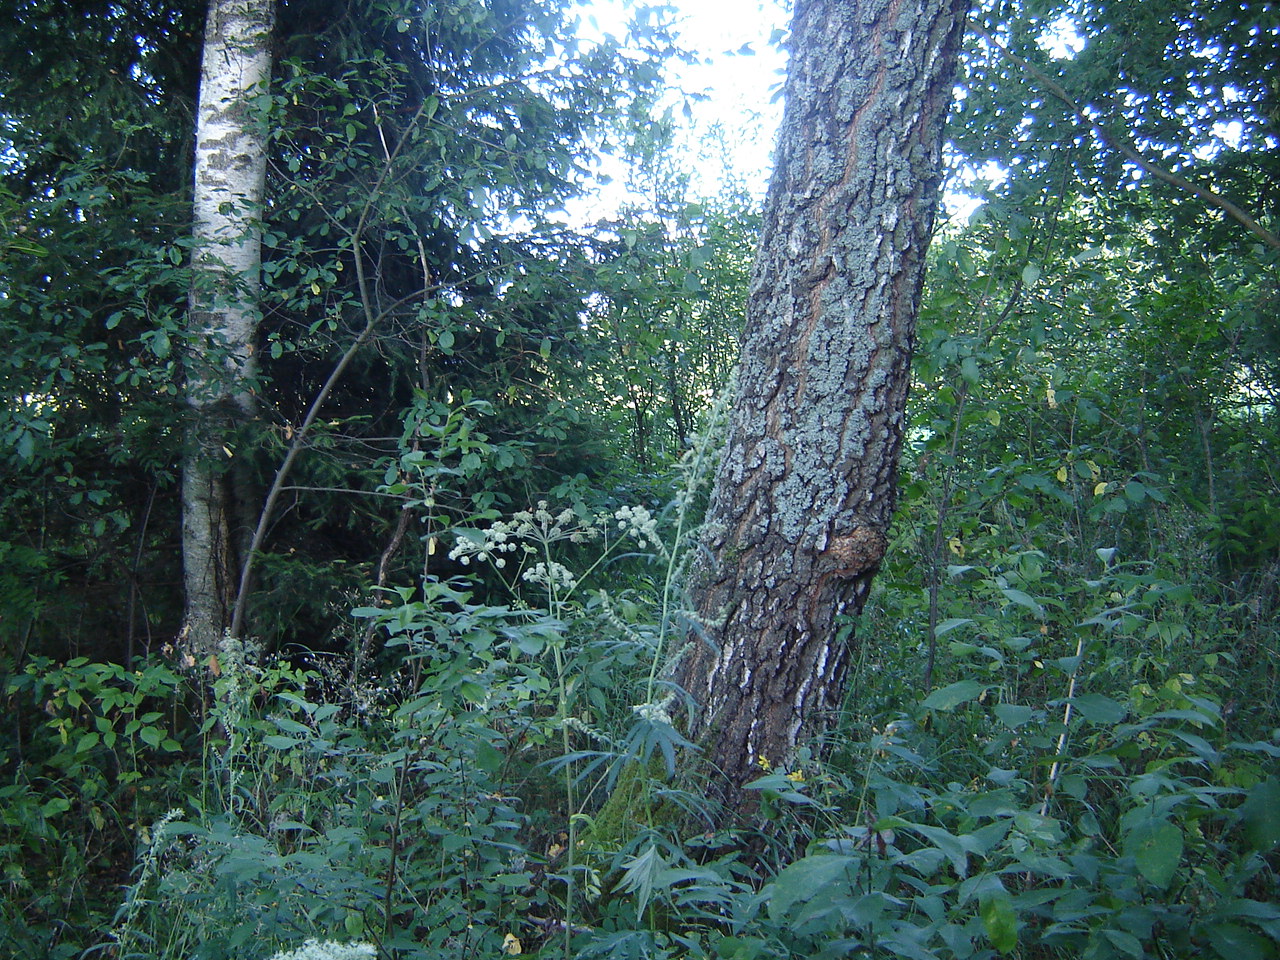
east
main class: Woodland
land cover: Other mixed woodland
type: hemiboreal forest and nemoral coniferous forest and mixed broadleaved-coniferous forest
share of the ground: > 75 %
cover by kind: broadleaved forest trees 55 %, coniferous forest trees 30 %, herbaceous plants 10 %, shrubs 5 %
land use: Forestry
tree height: > 5 m
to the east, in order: Other mixed woodland; Shruby margins; Grassland without tree/shrub cover; Broadleaved woodland; Fences; Grassland without tree/shrub cover; Paved roads, cycling and walking lanes
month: August
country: LT
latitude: 54.9763
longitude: 24.9390
